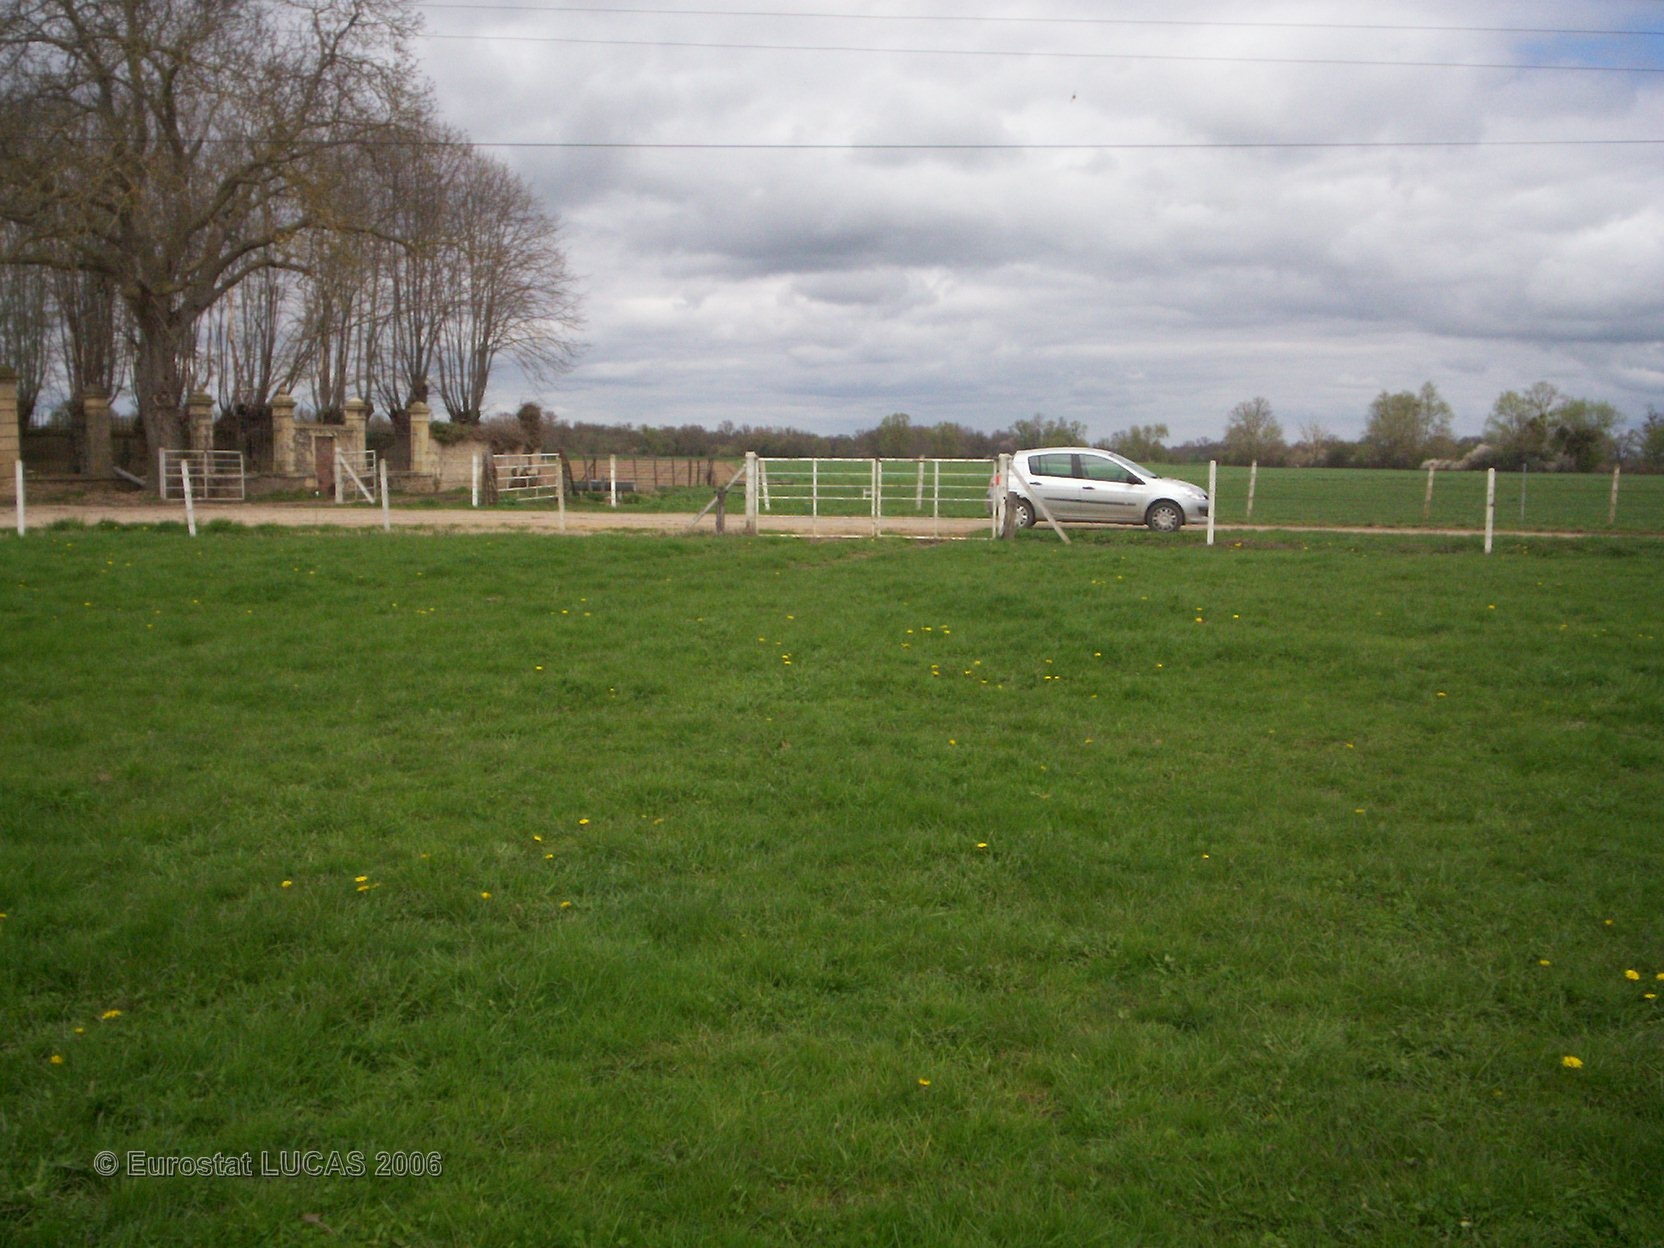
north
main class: Grassland
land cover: Grassland without tree/shrub cover
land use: Agriculture (excluding fallow land and kitchen gardens)
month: April
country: FR
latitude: 46.7931
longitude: 3.0399
